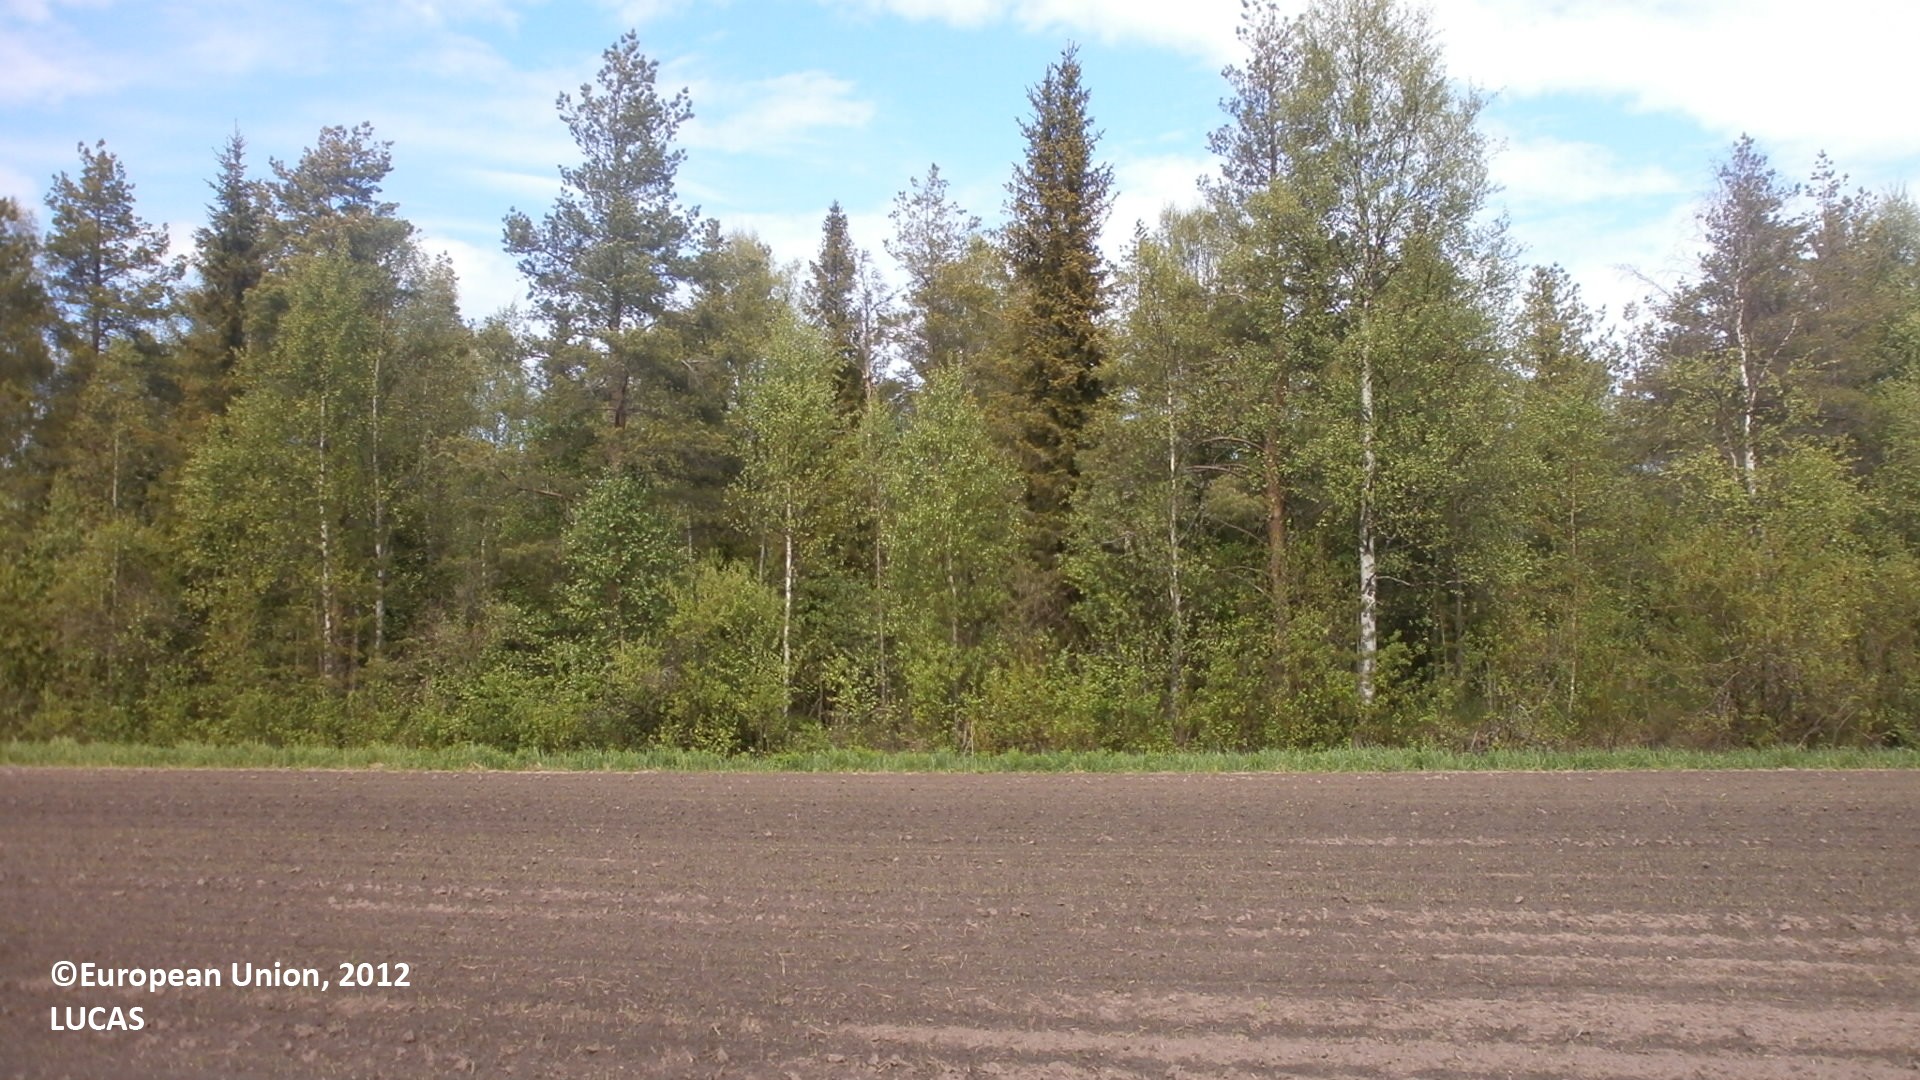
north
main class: Cropland
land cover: Barley
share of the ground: < 10 %
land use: Agriculture (excluding fallow land and kitchen gardens)
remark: Tilled/Sowed
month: June
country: FI
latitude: 64.4838
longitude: 25.0822
